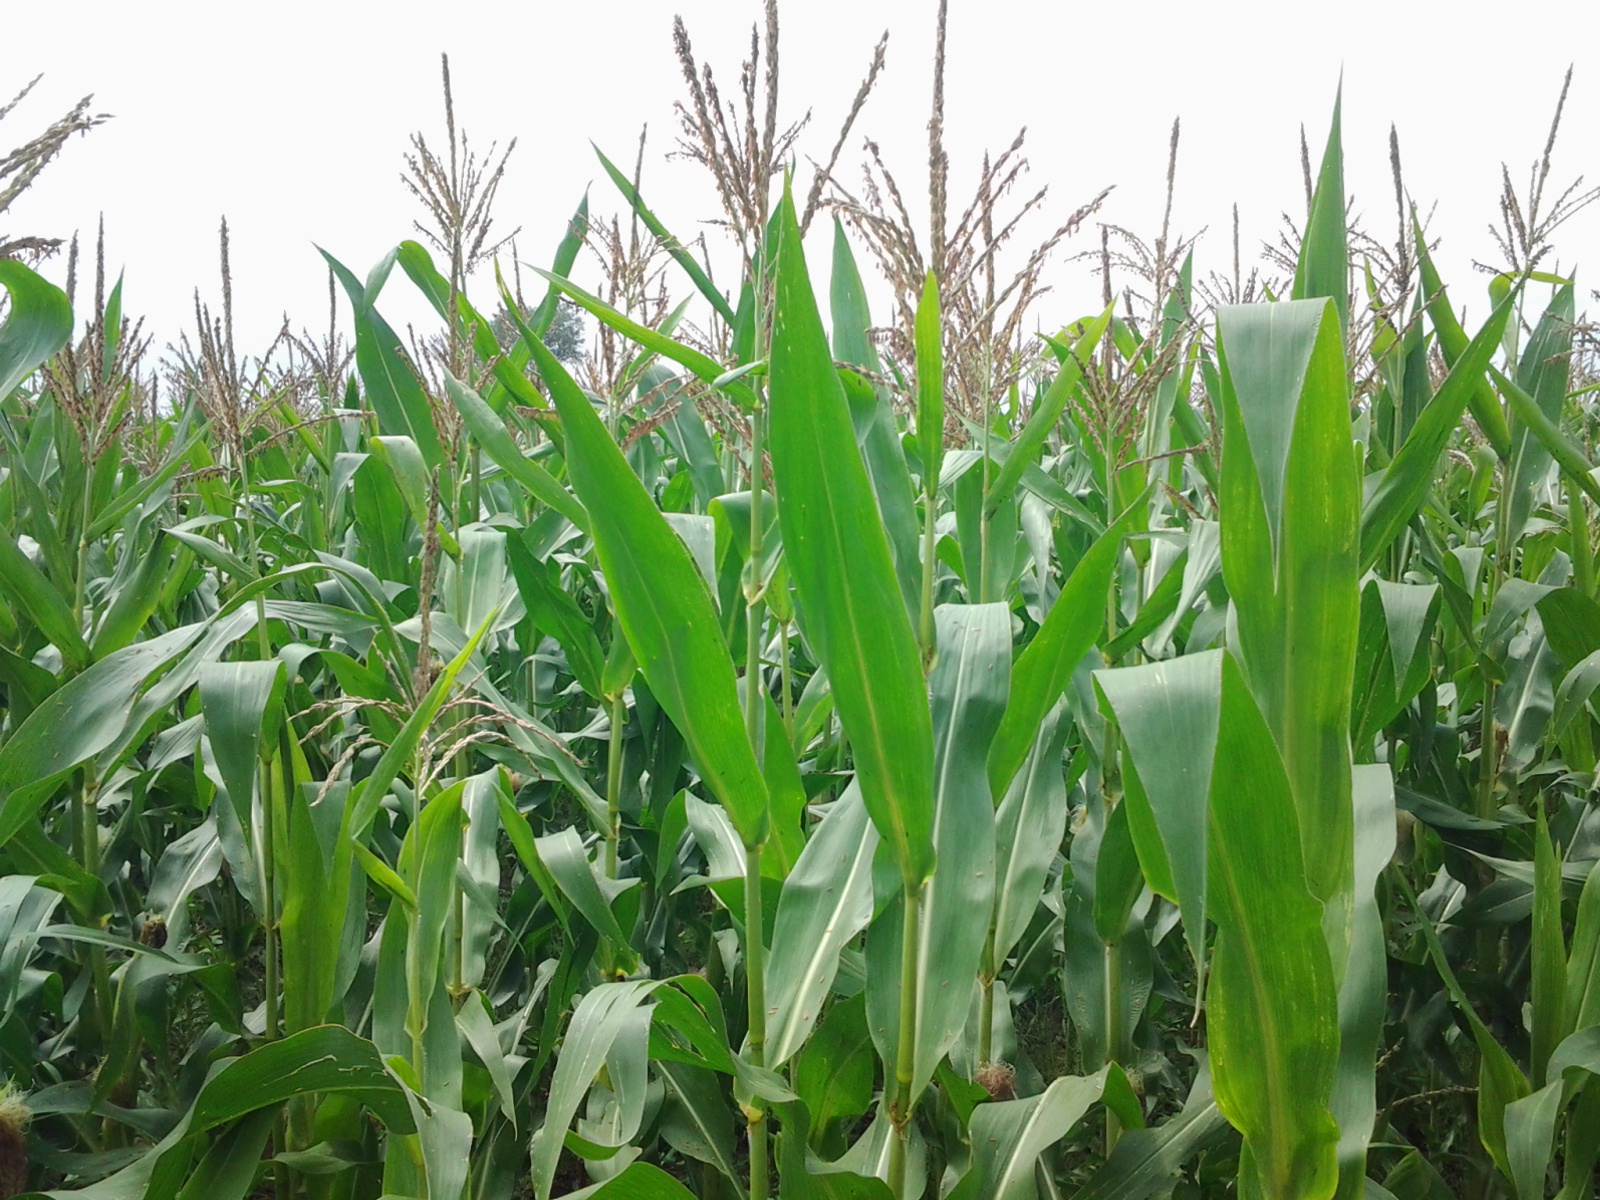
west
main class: Cropland
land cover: Maize
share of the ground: > 75 %
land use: Agriculture (excluding fallow land and kitchen gardens)
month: June
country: HU
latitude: 47.1180
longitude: 20.1615
